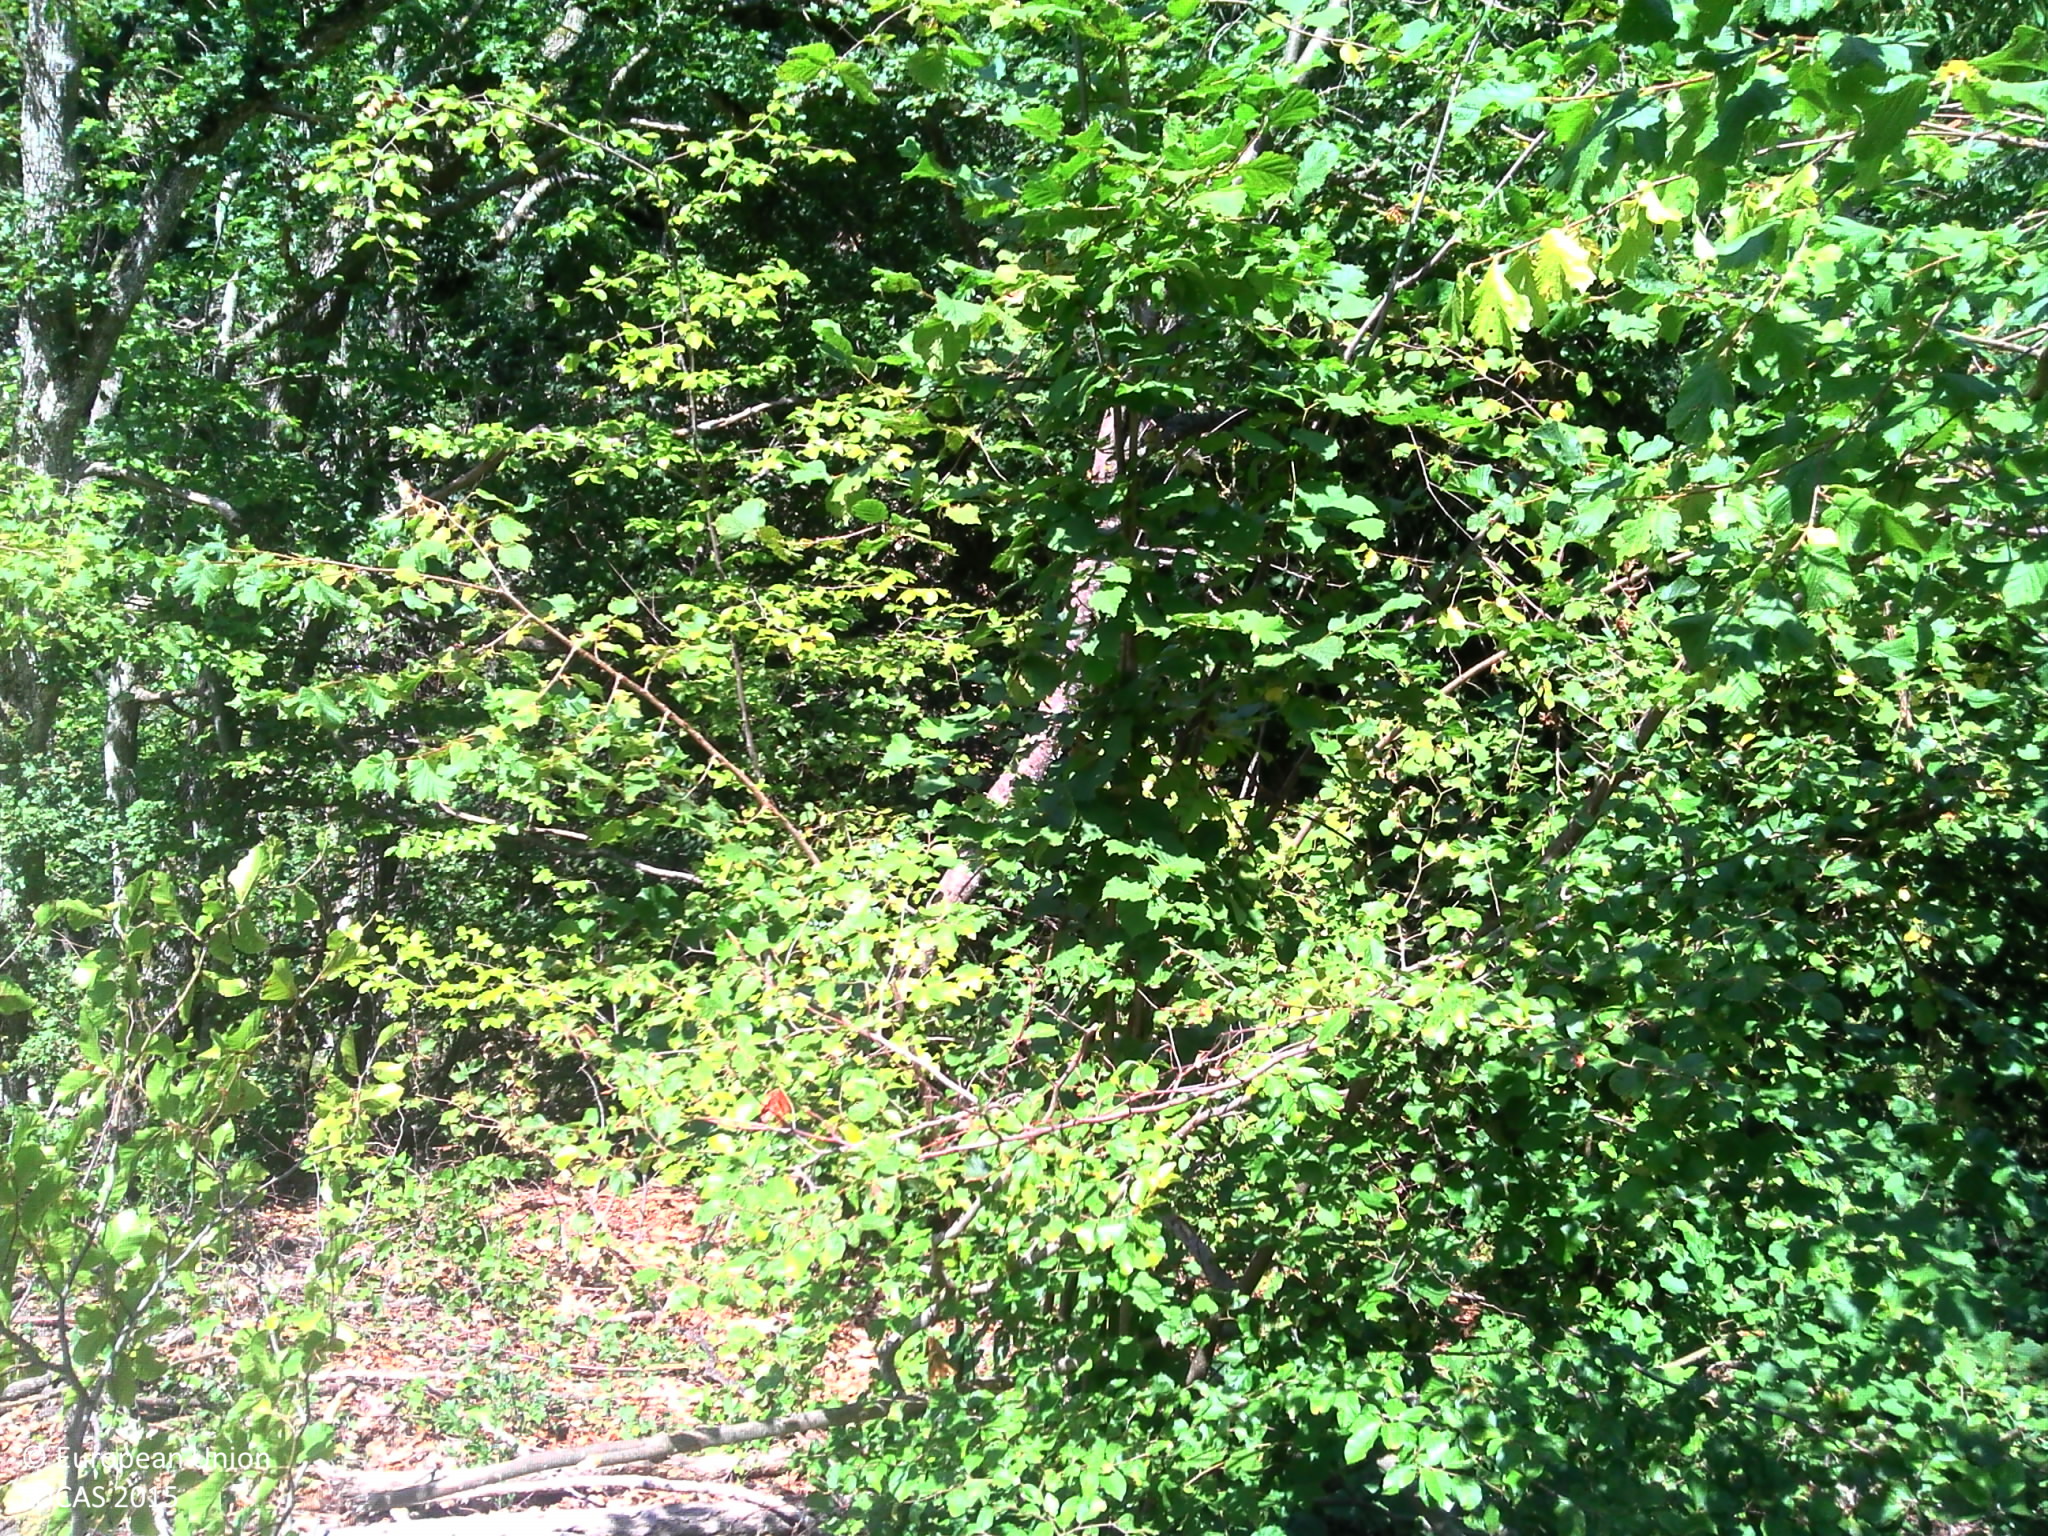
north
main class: Shrubland
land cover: Shrubland with sparse tree cover
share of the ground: > 75 %
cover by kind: shrubs 60 %, unconsolidated bare surface 20 %, herbaceous plants 15 %, broadleaved forest trees 5 %
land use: Forestry
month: July
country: FR
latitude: 45.1022
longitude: 2.8974
